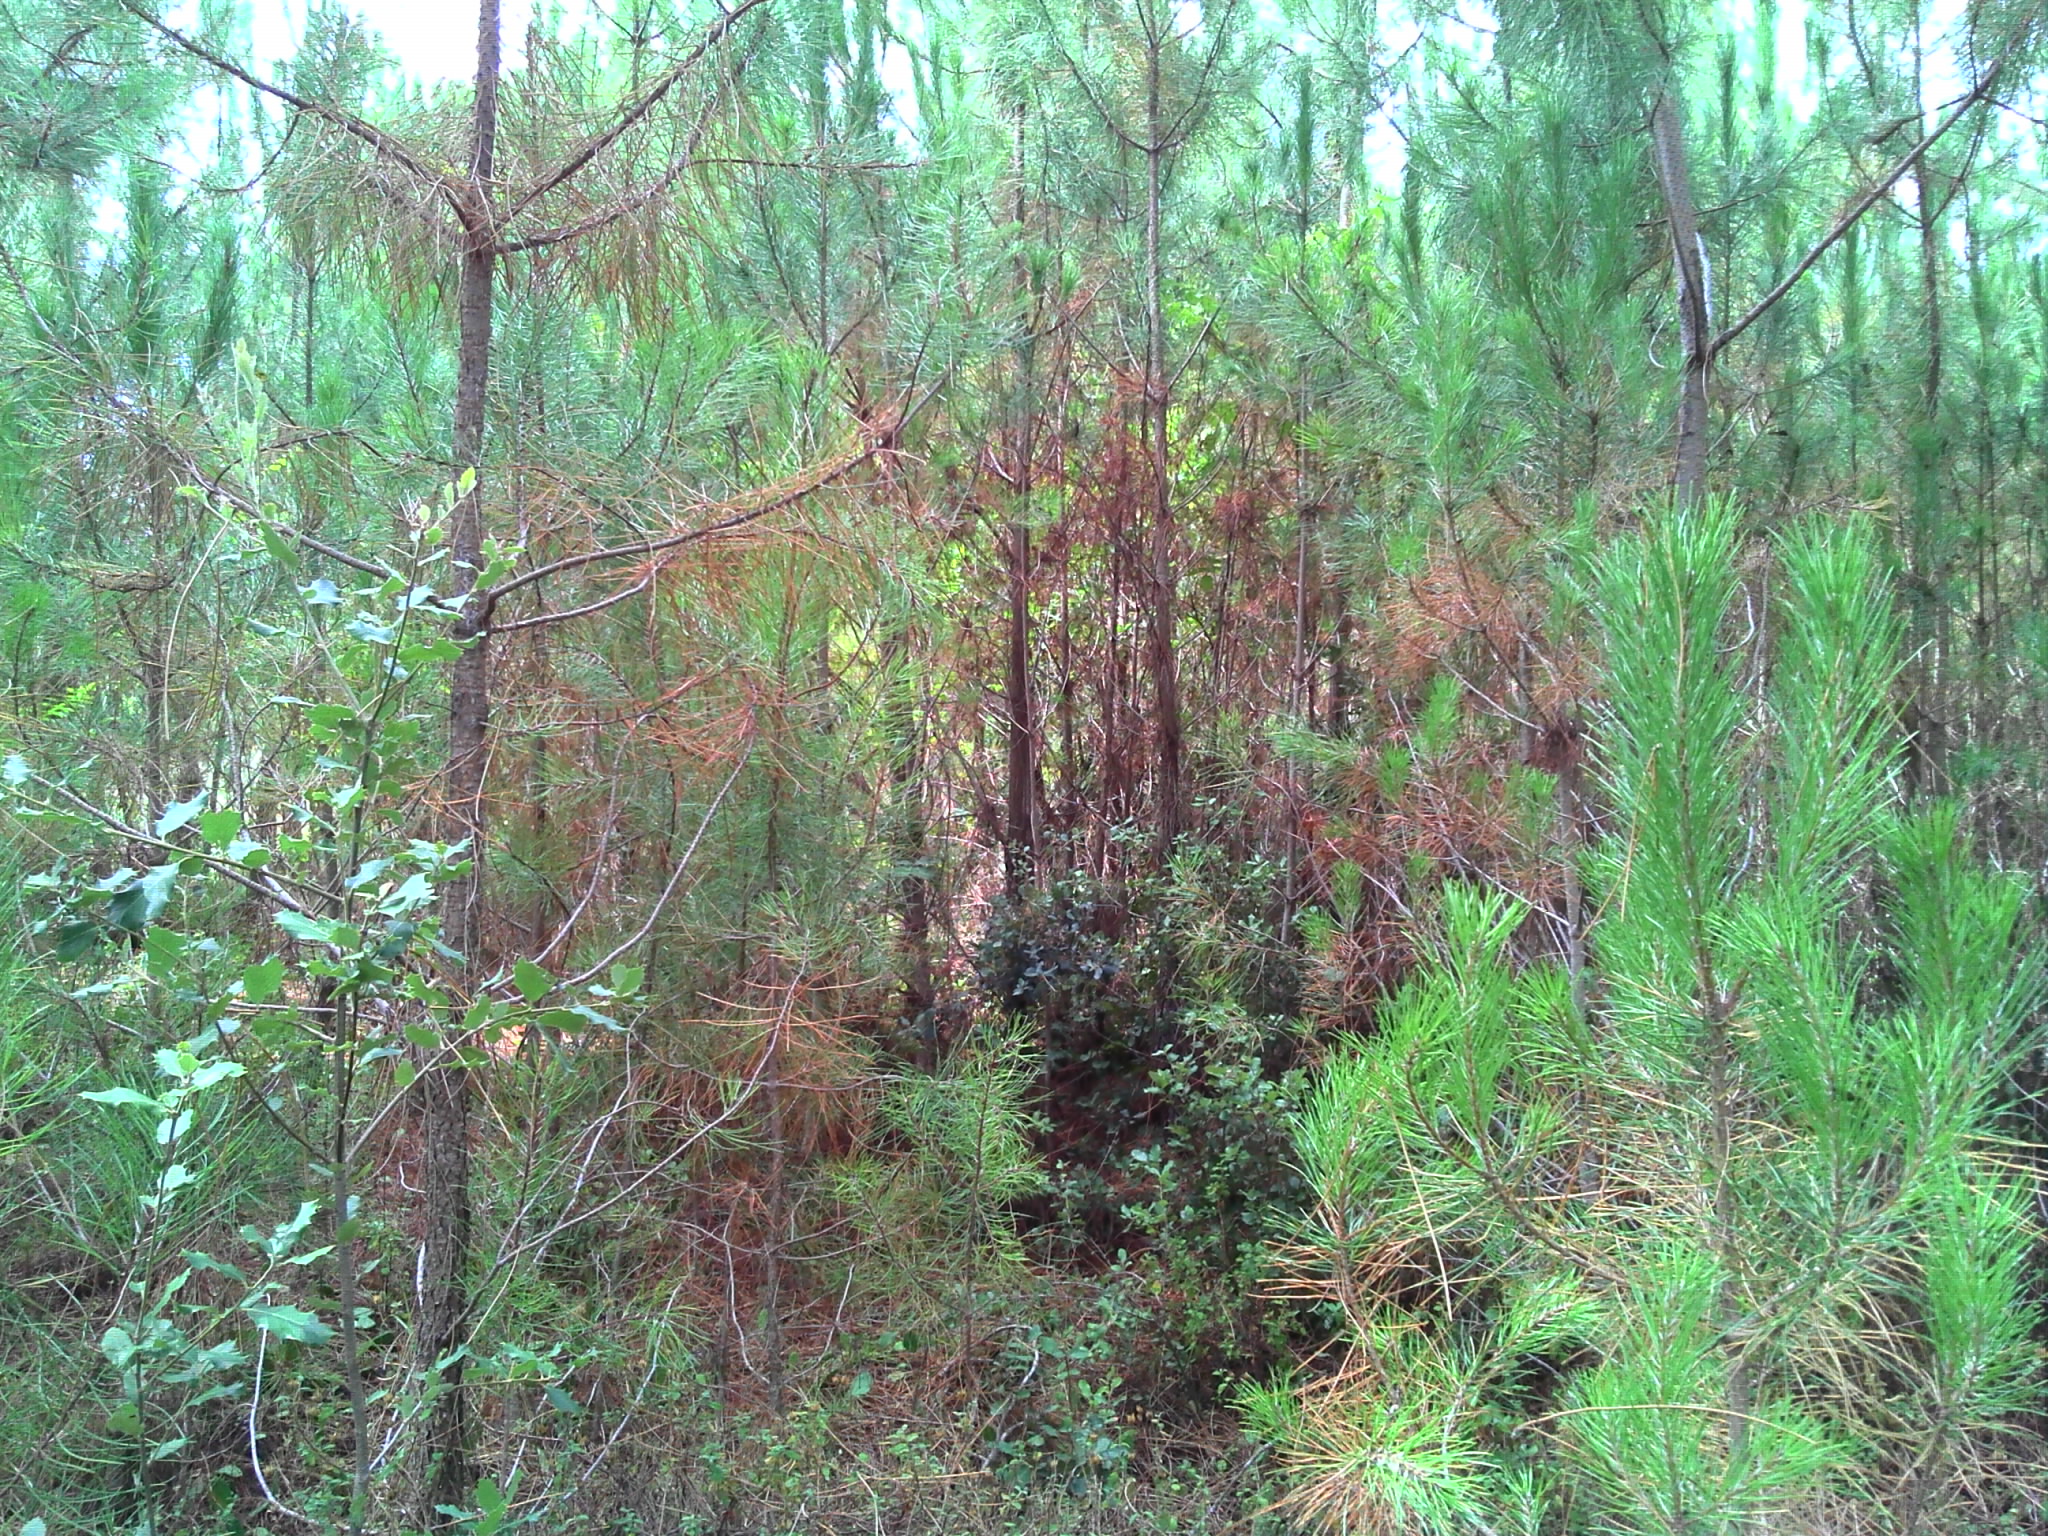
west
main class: Woodland
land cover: Pine dominated coniferous woodland
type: coniferous forest of the mediterranean region
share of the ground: > 75 %
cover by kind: coniferous forest trees 60 %, herbaceous plants 20 %, shrubs 10 %, consolidated bare surface 10 %
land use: Semi-natural and natural areas not in use
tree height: > 5 m
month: August
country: FR
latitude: 44.1387
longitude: 4.6204
